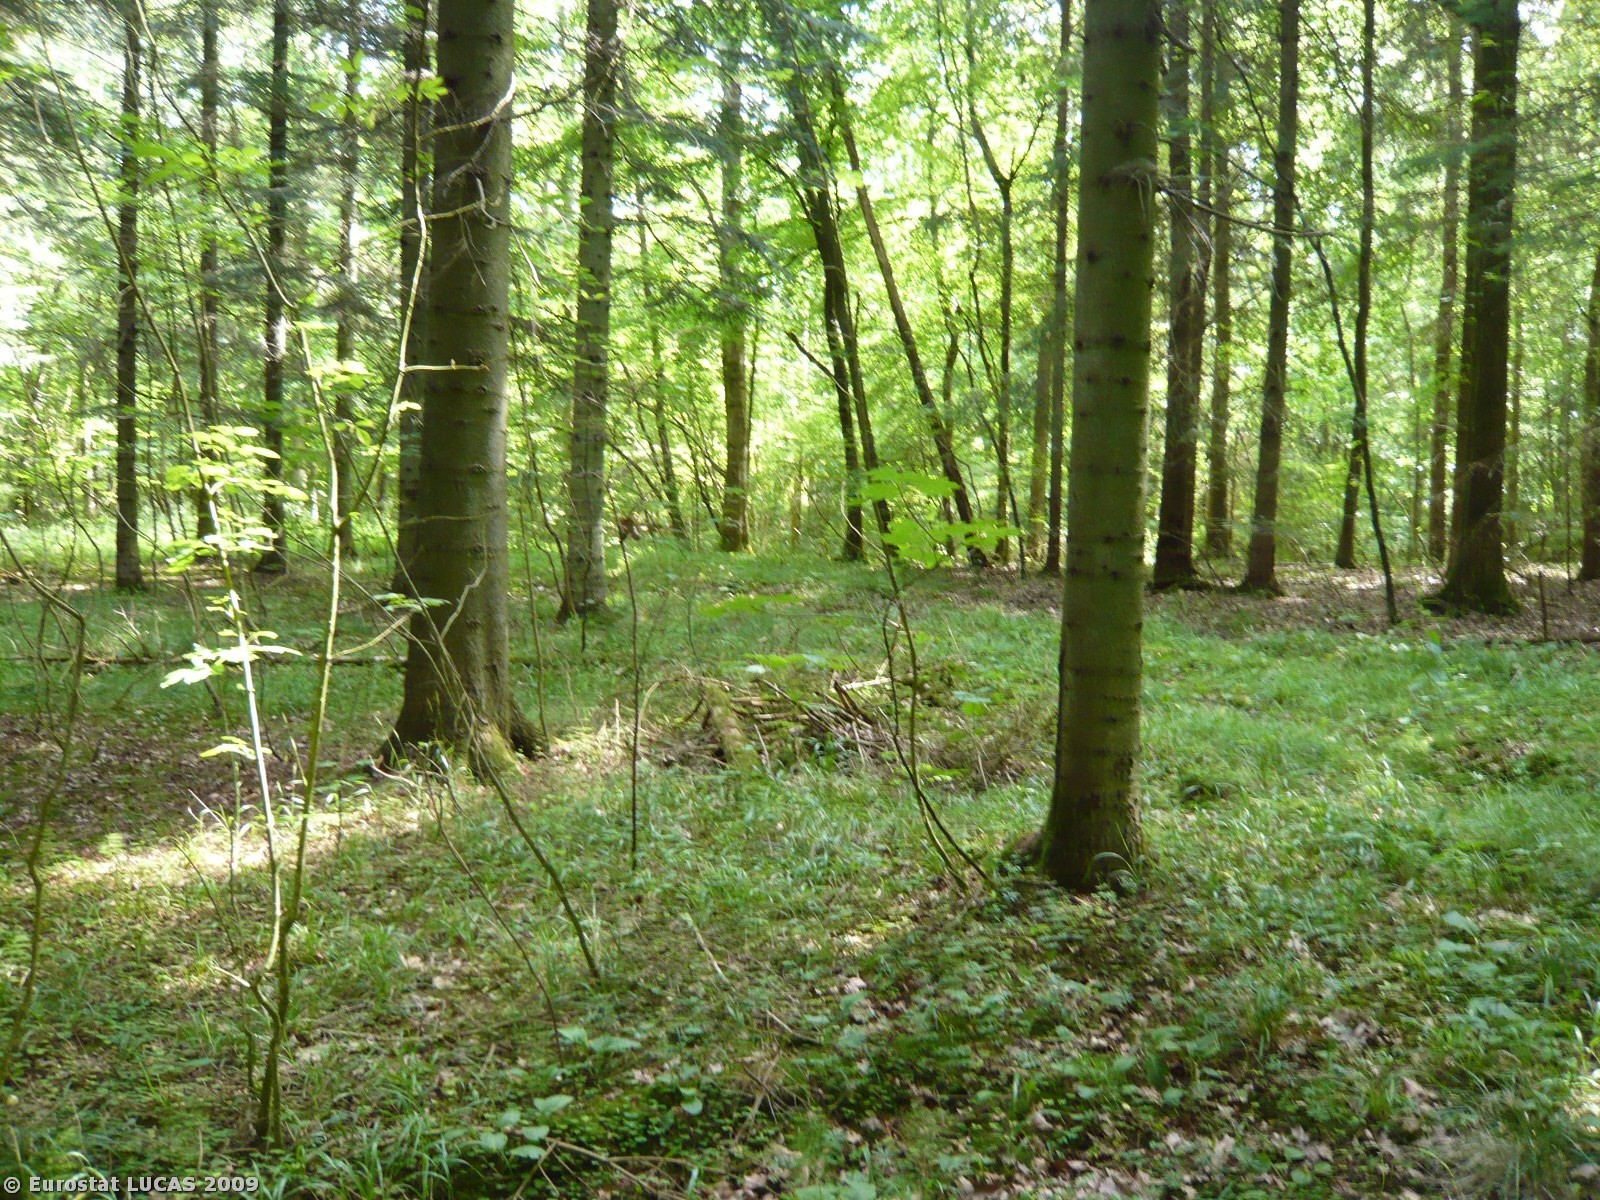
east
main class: Woodland
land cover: Coniferous woodland
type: hemiboreal forest and nemoral coniferous forest and mixed broadleaved-coniferous forest
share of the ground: > 75 %
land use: Forestry
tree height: > 5 m
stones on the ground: < 10 %
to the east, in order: Coniferous woodland; Broadleaved woodland; Ditches and canals; Broadleaved woodland
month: July
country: DK
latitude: 55.5451
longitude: 11.8527
